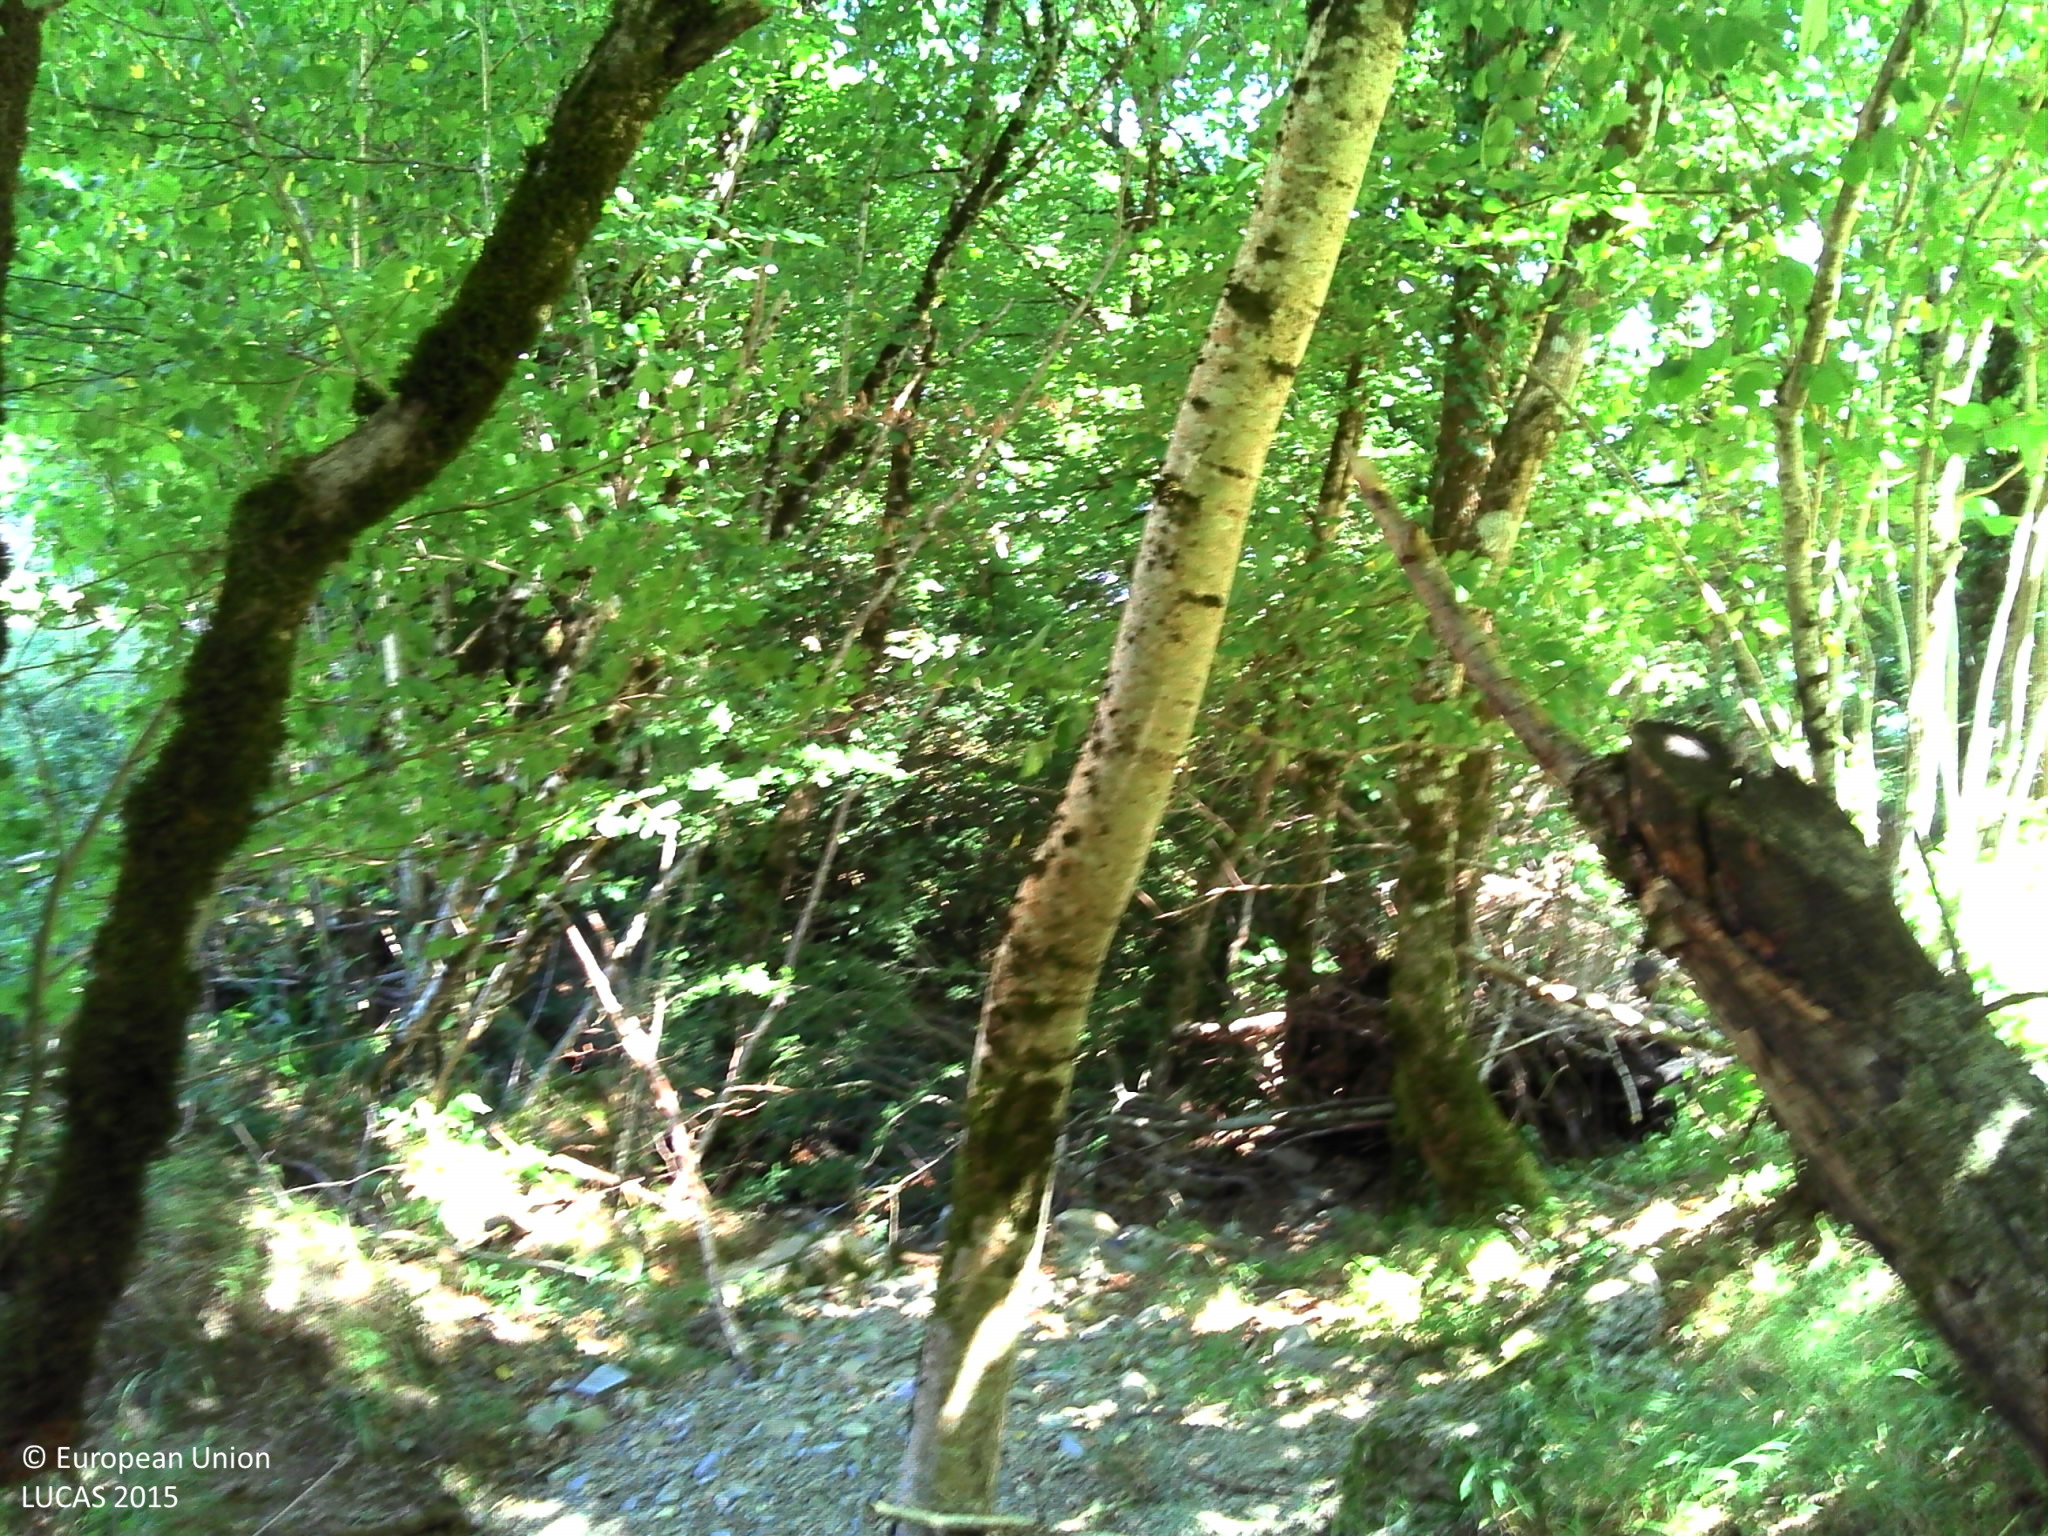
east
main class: Cropland
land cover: Temporary grasslands
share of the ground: > 75 %
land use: Agriculture (excluding fallow land and kitchen gardens)
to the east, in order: Groves; Ditches and canals; Broadleaved woodland; Rivers and streams; Broadleaved woodland
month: August
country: FR
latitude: 43.7188
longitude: 3.0441
